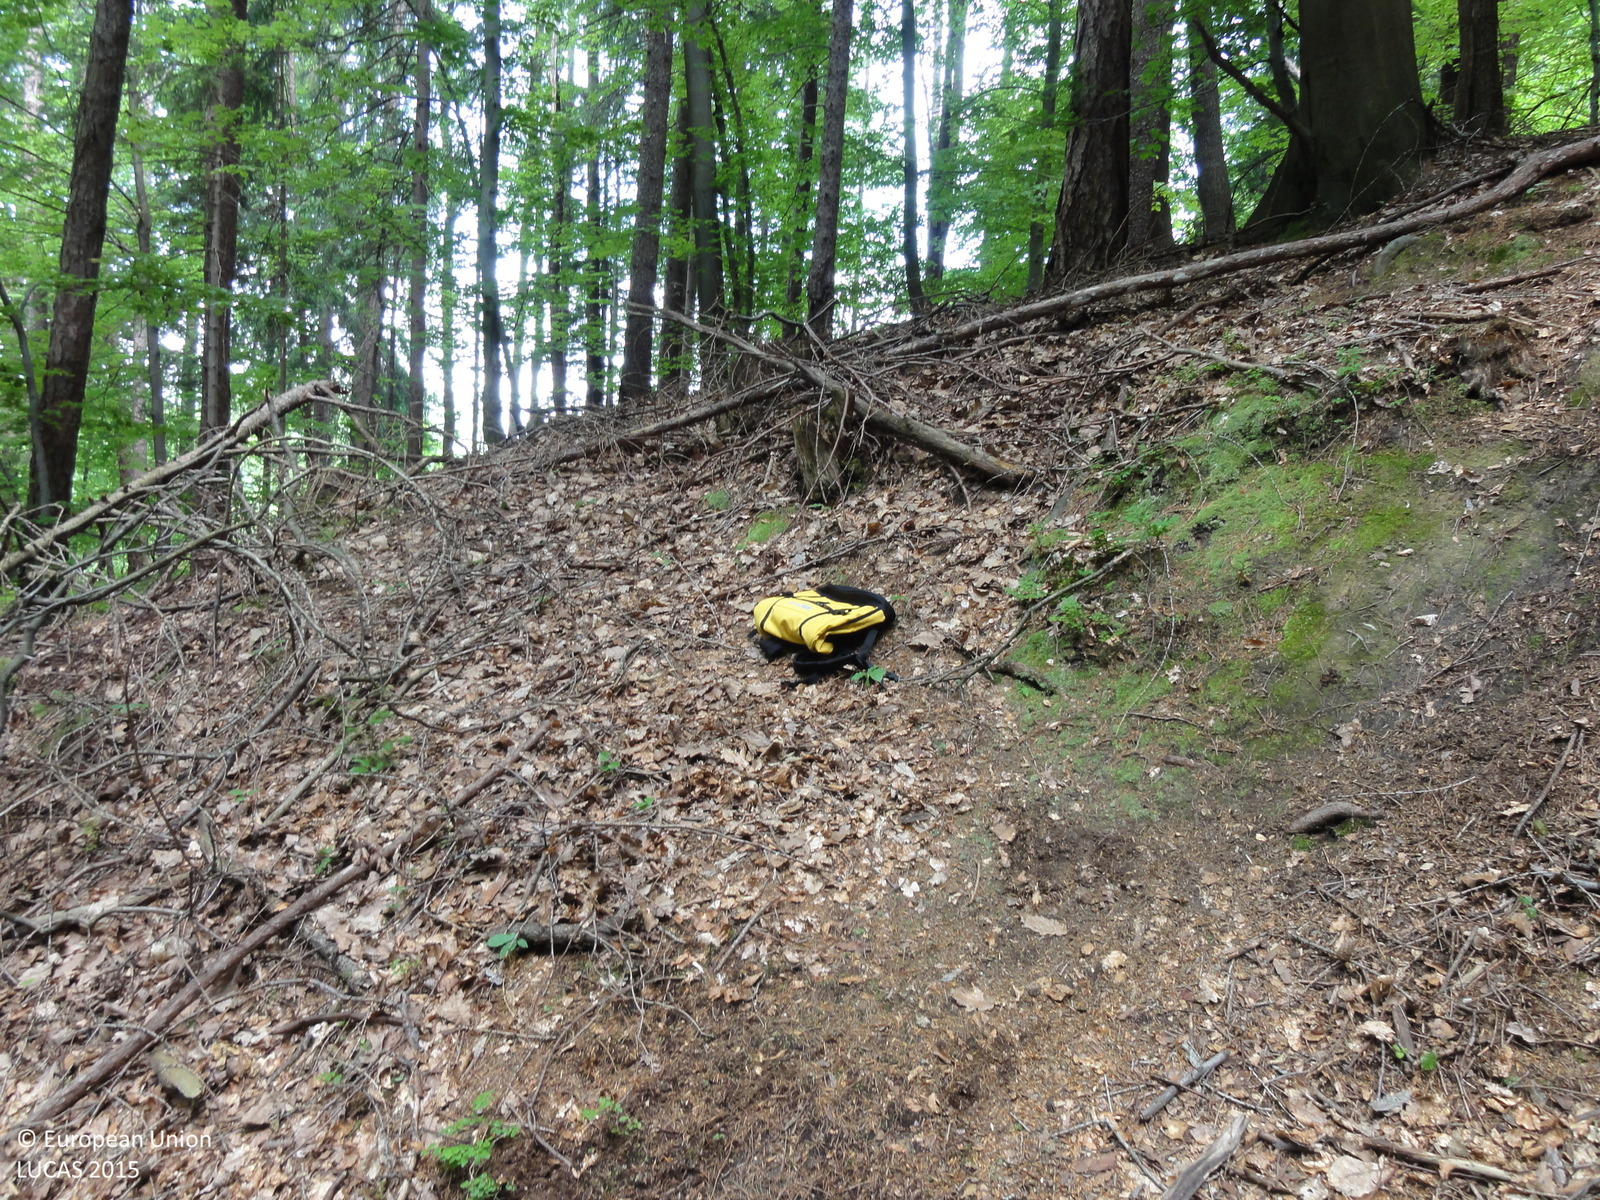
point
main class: Woodland
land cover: Other mixed woodland
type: mountainous beech forest
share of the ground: > 75 %
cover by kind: coniferous forest trees 50 %, broadleaved forest trees 50 %
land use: Forestry
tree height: > 5 m
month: May
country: SI
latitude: 46.2299
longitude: 15.0932
